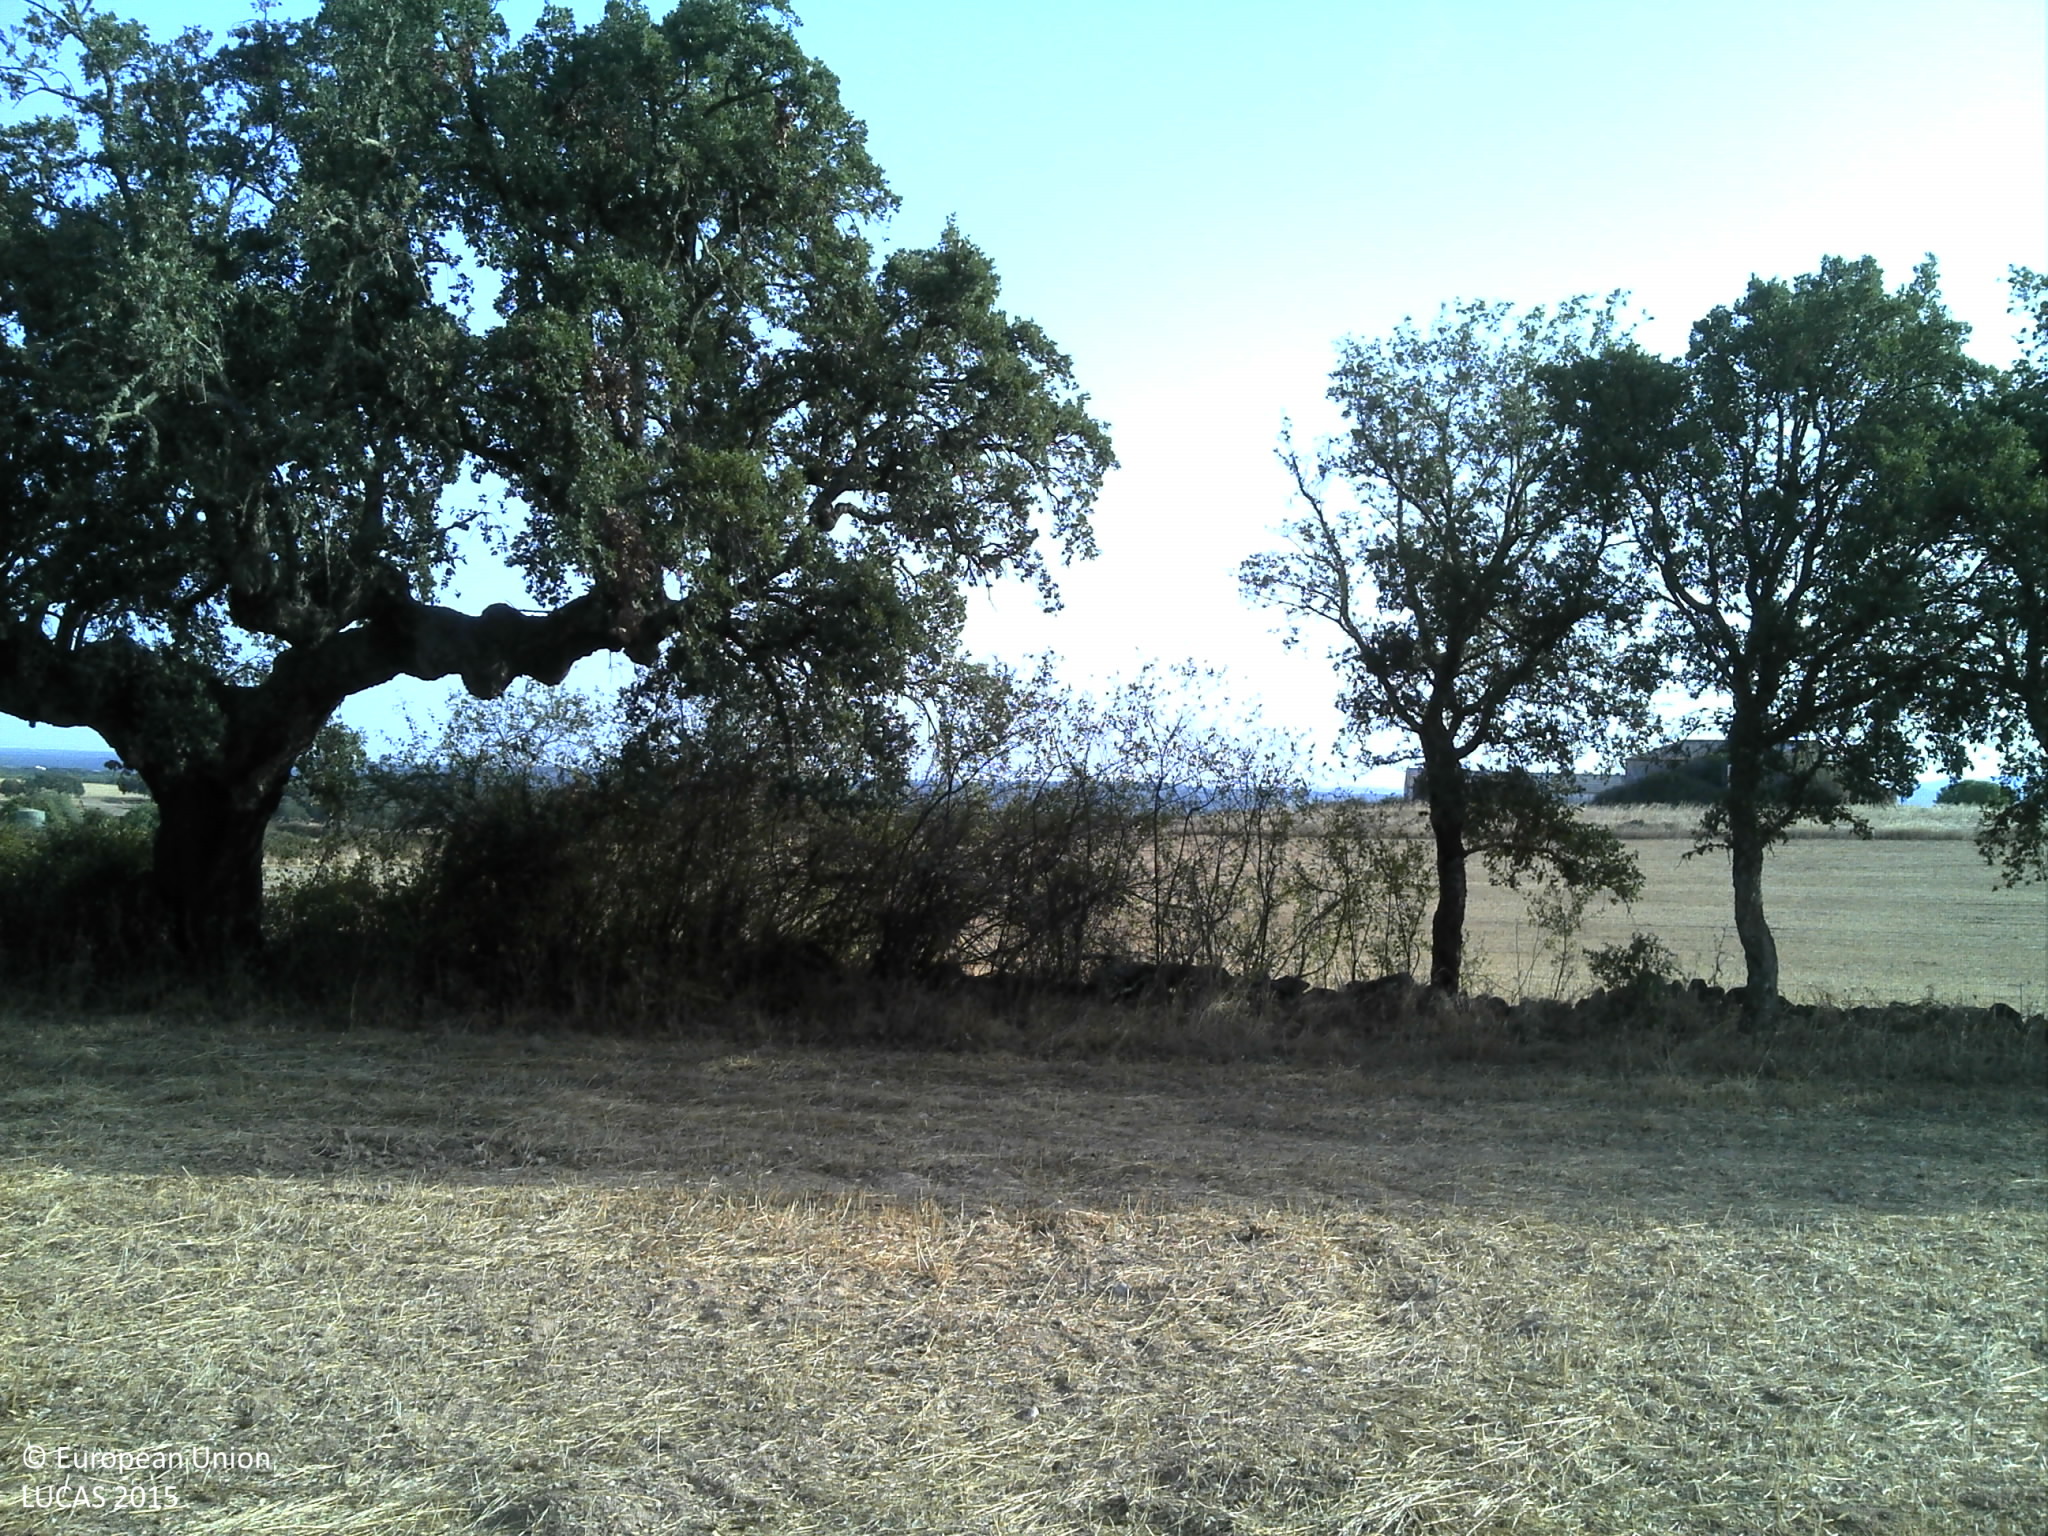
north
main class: Woodland
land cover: Broadleaved woodland
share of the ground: 10 - 25 %
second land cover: Common wheat
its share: > 75 %
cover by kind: herbaceous plants 75 %, unconsolidated bare surface 15 %, broadleaved forest trees 10 %
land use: Forestry
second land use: Agriculture (excluding fallow land and kitchen gardens)
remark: Harvested field
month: August
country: PT
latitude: 39.2395
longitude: -7.5733
